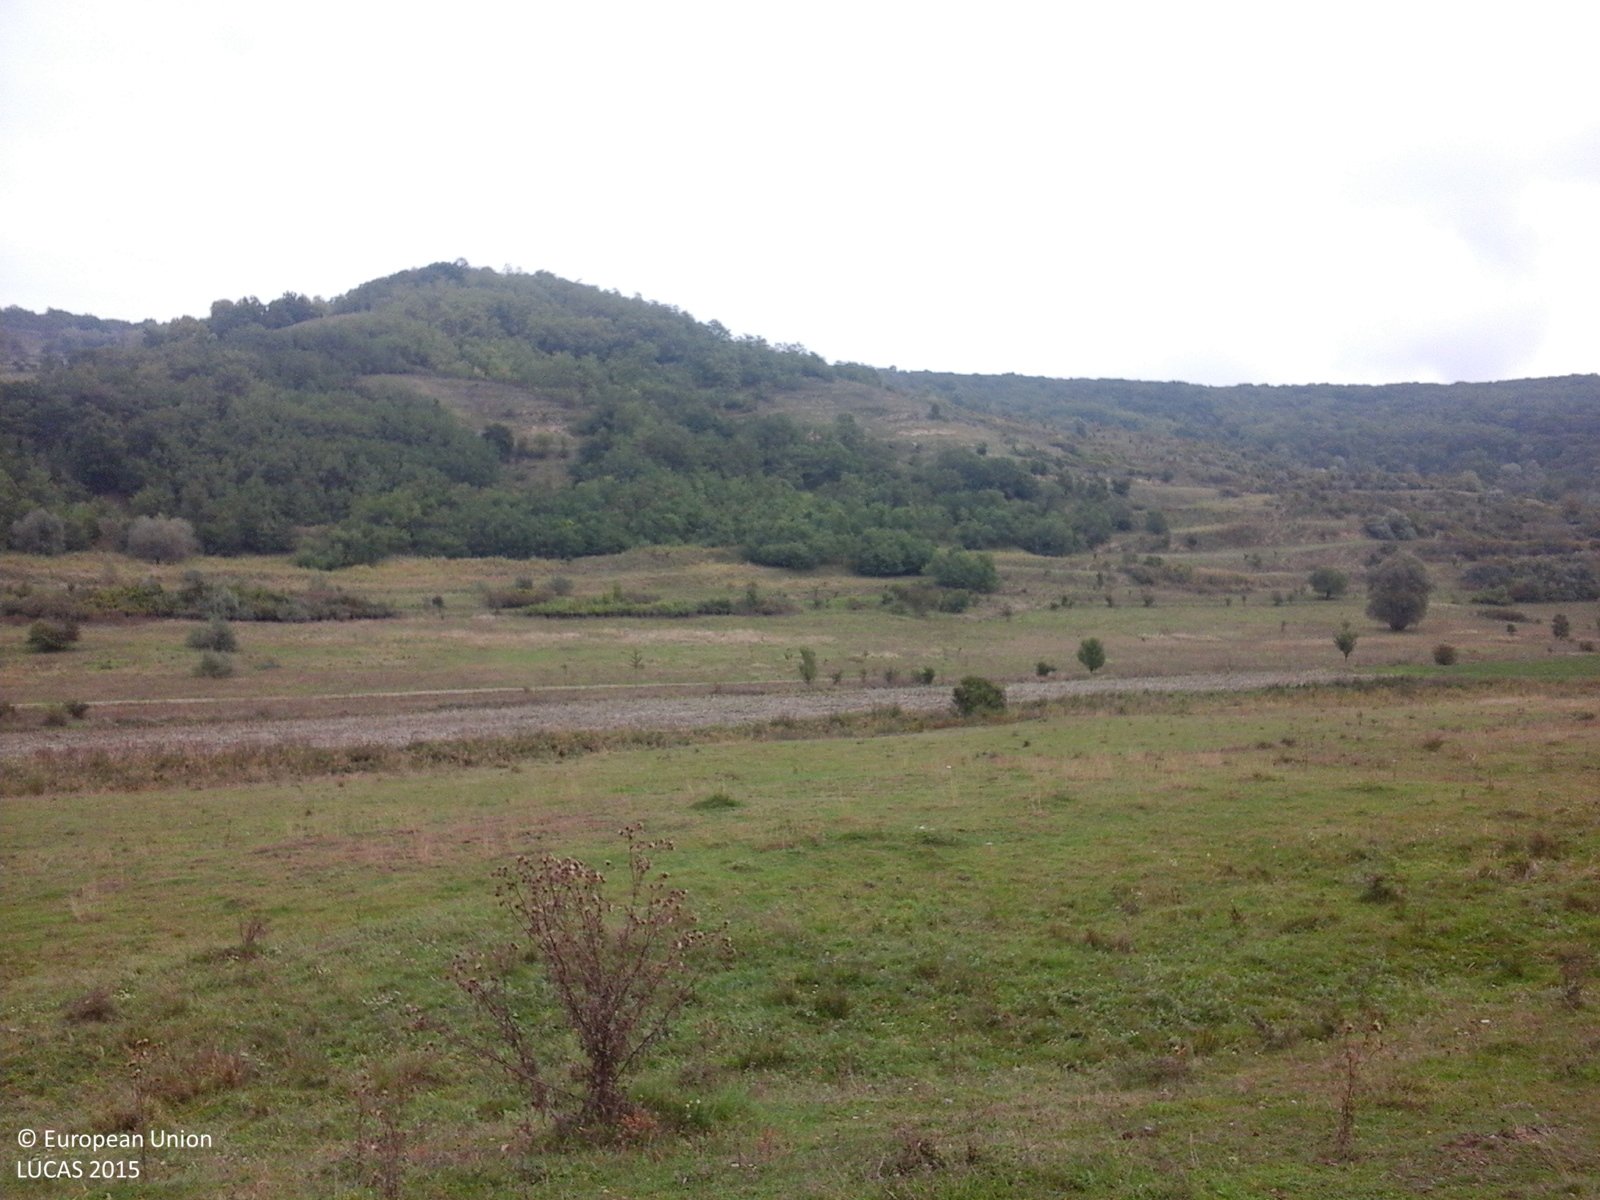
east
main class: Grassland
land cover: Grassland without tree/shrub cover
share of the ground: > 75 %
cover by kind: herbaceous plants 100 %
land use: Agriculture (excluding fallow land and kitchen gardens)
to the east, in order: Grassland without tree/shrub cover; Ditches and canals; Shruby margins; Sunflower; Spontaneously vegetated surfaces; Tracks; Grassland without tree/shrub cover
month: October
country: RO
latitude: 46.1958
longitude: 24.1107
